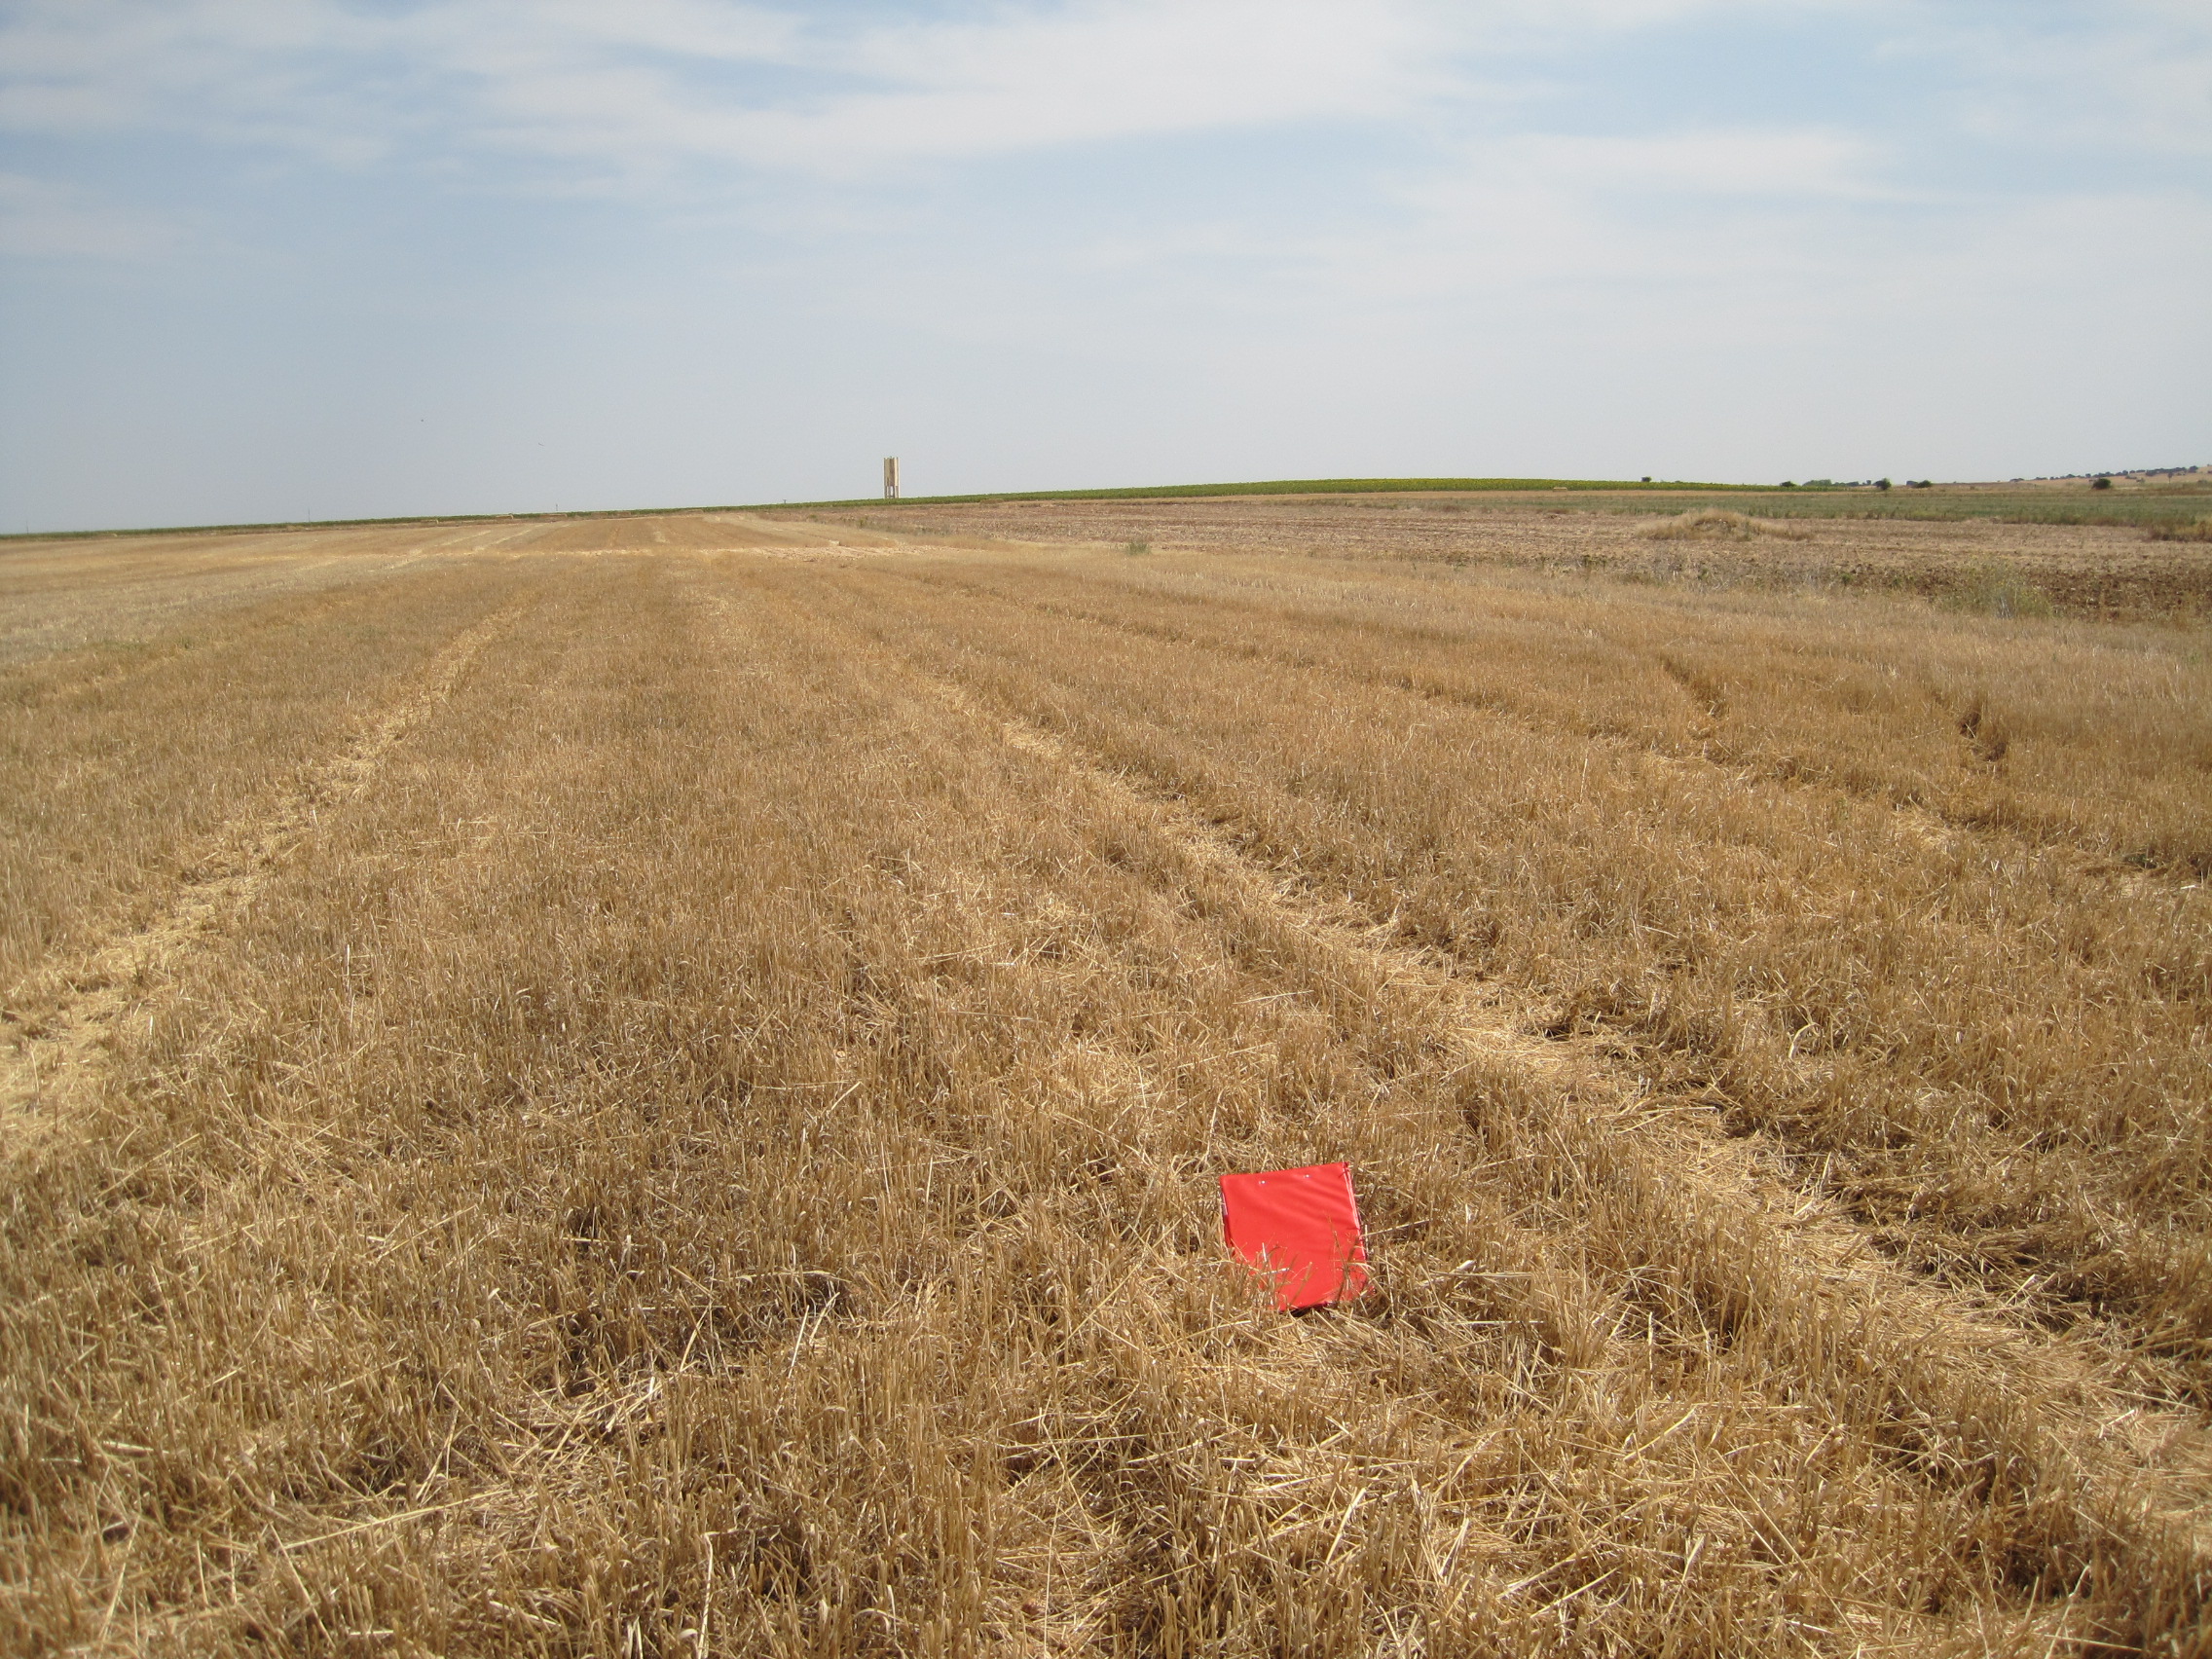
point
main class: Cropland
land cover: Common wheat
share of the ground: < 10 %
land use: Agriculture (excluding fallow land and kitchen gardens)
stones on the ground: 25 - 50 %
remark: Harvested field
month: July
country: ES
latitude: 41.7618
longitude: -5.5173
